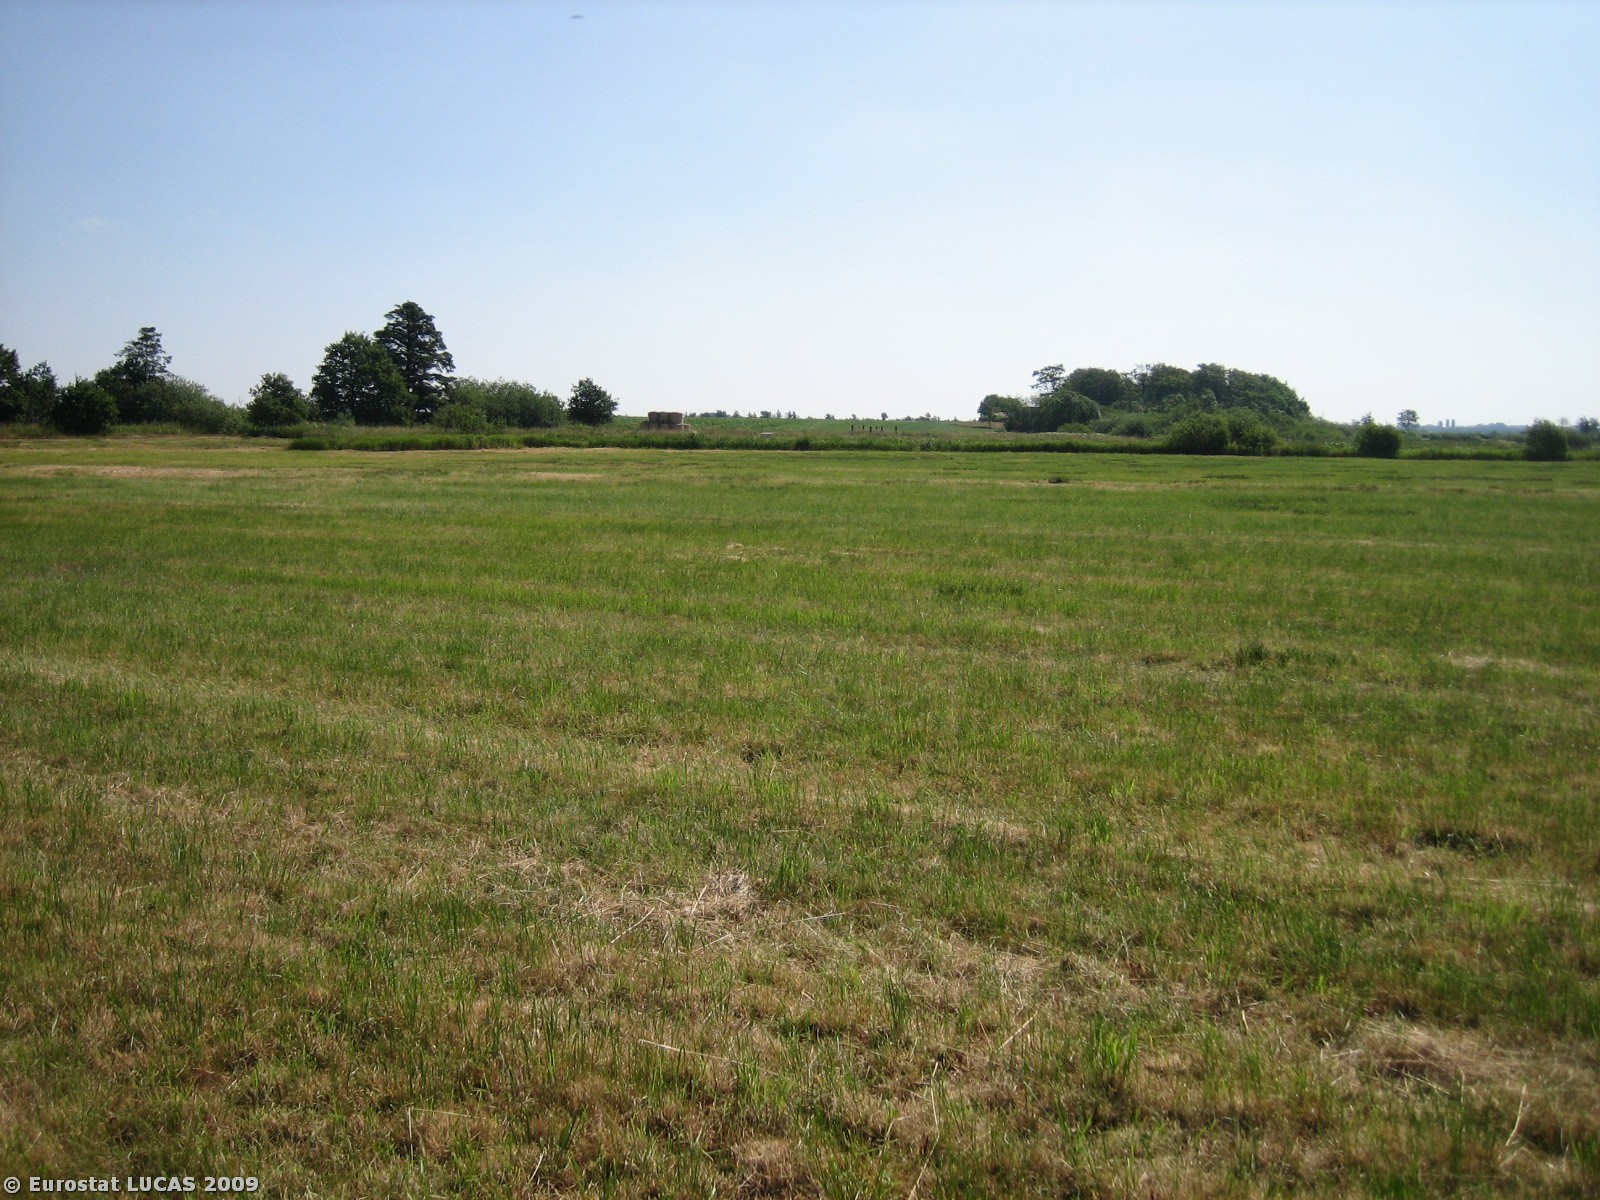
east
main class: Cropland
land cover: Temporary grasslands
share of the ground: > 75 %
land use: Agriculture (excluding fallow land and kitchen gardens)
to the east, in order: Temporary grasslands; Grass margins; Ditches and canals; Fences; Grass margins; Grassland without tree/shrub cover; Fences; Grass margins; Tracks
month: July
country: DK
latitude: 55.4099
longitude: 8.8796
